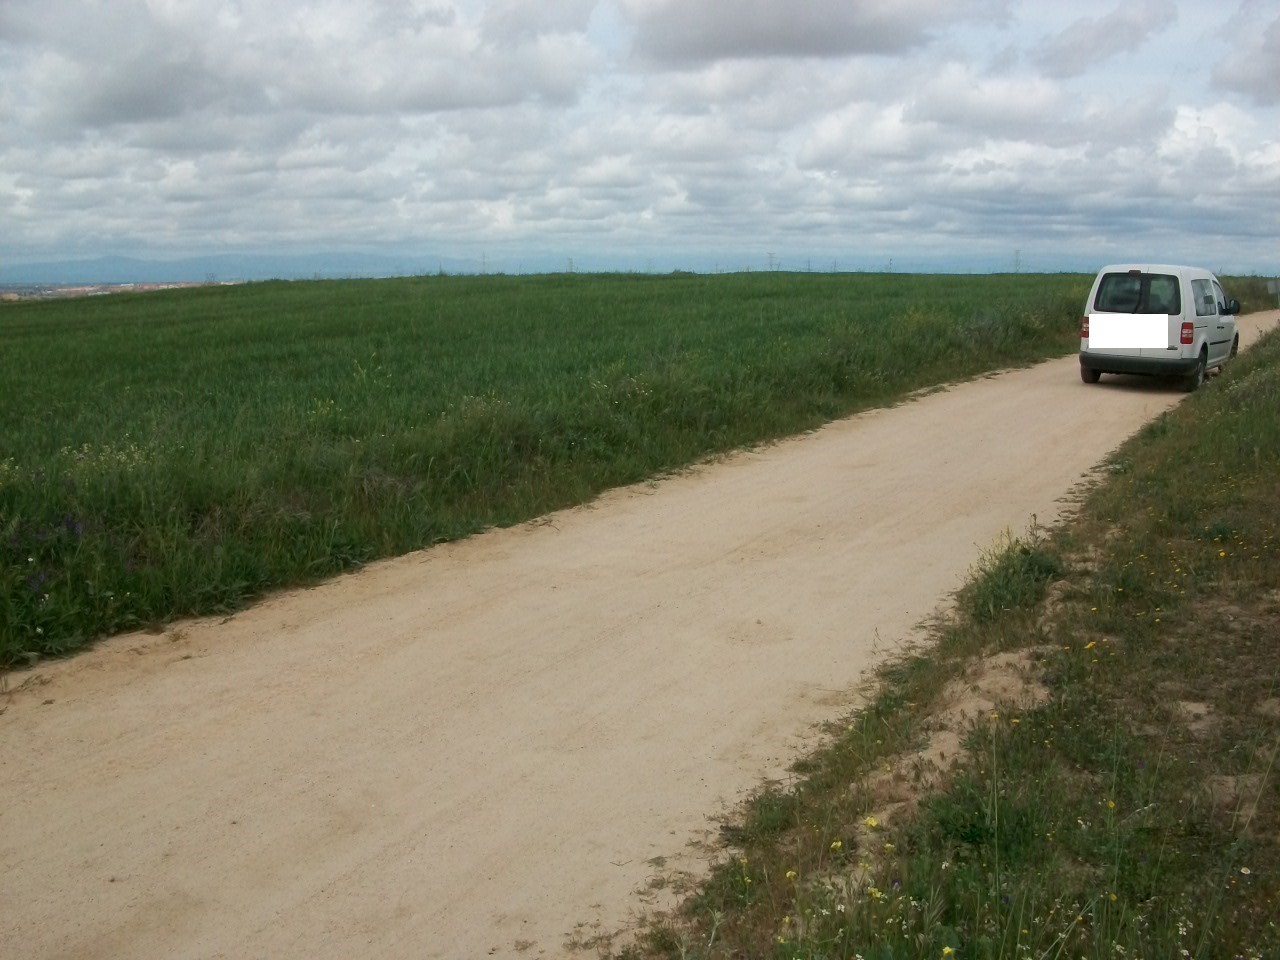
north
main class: Cropland
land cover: Olive groves
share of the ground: 25 - 50 %
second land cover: Grassland without tree/shrub cover
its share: > 75 %
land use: Agriculture (excluding fallow land and kitchen gardens)
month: April
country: ES
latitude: 40.2298
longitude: -3.8703
